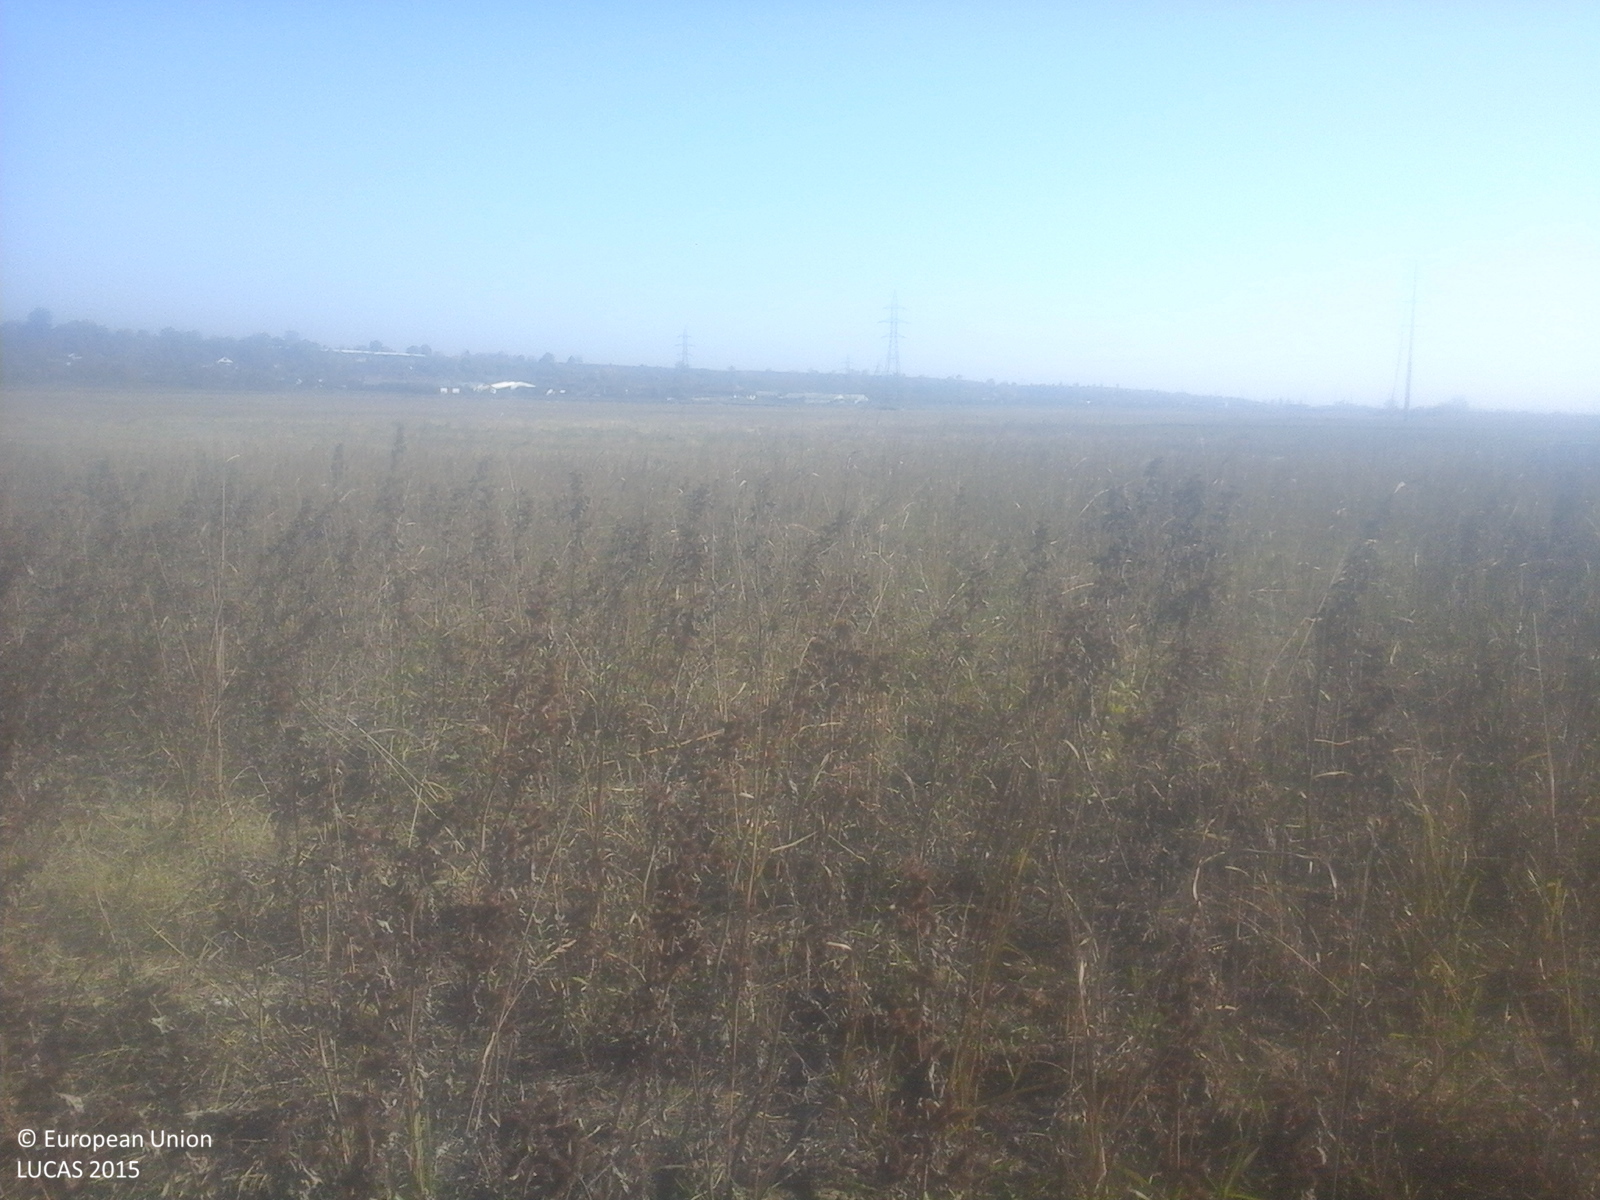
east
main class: Grassland
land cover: Spontaneously vegetated surfaces
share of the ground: > 75 %
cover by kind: herbaceous plants 100 %
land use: Fallow land
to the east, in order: Spontaneously vegetated surfaces; Grassland without tree/shrub cover; Tracks; Grassland without tree/shrub cover
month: October
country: RO
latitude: 45.8826
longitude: 27.0892
